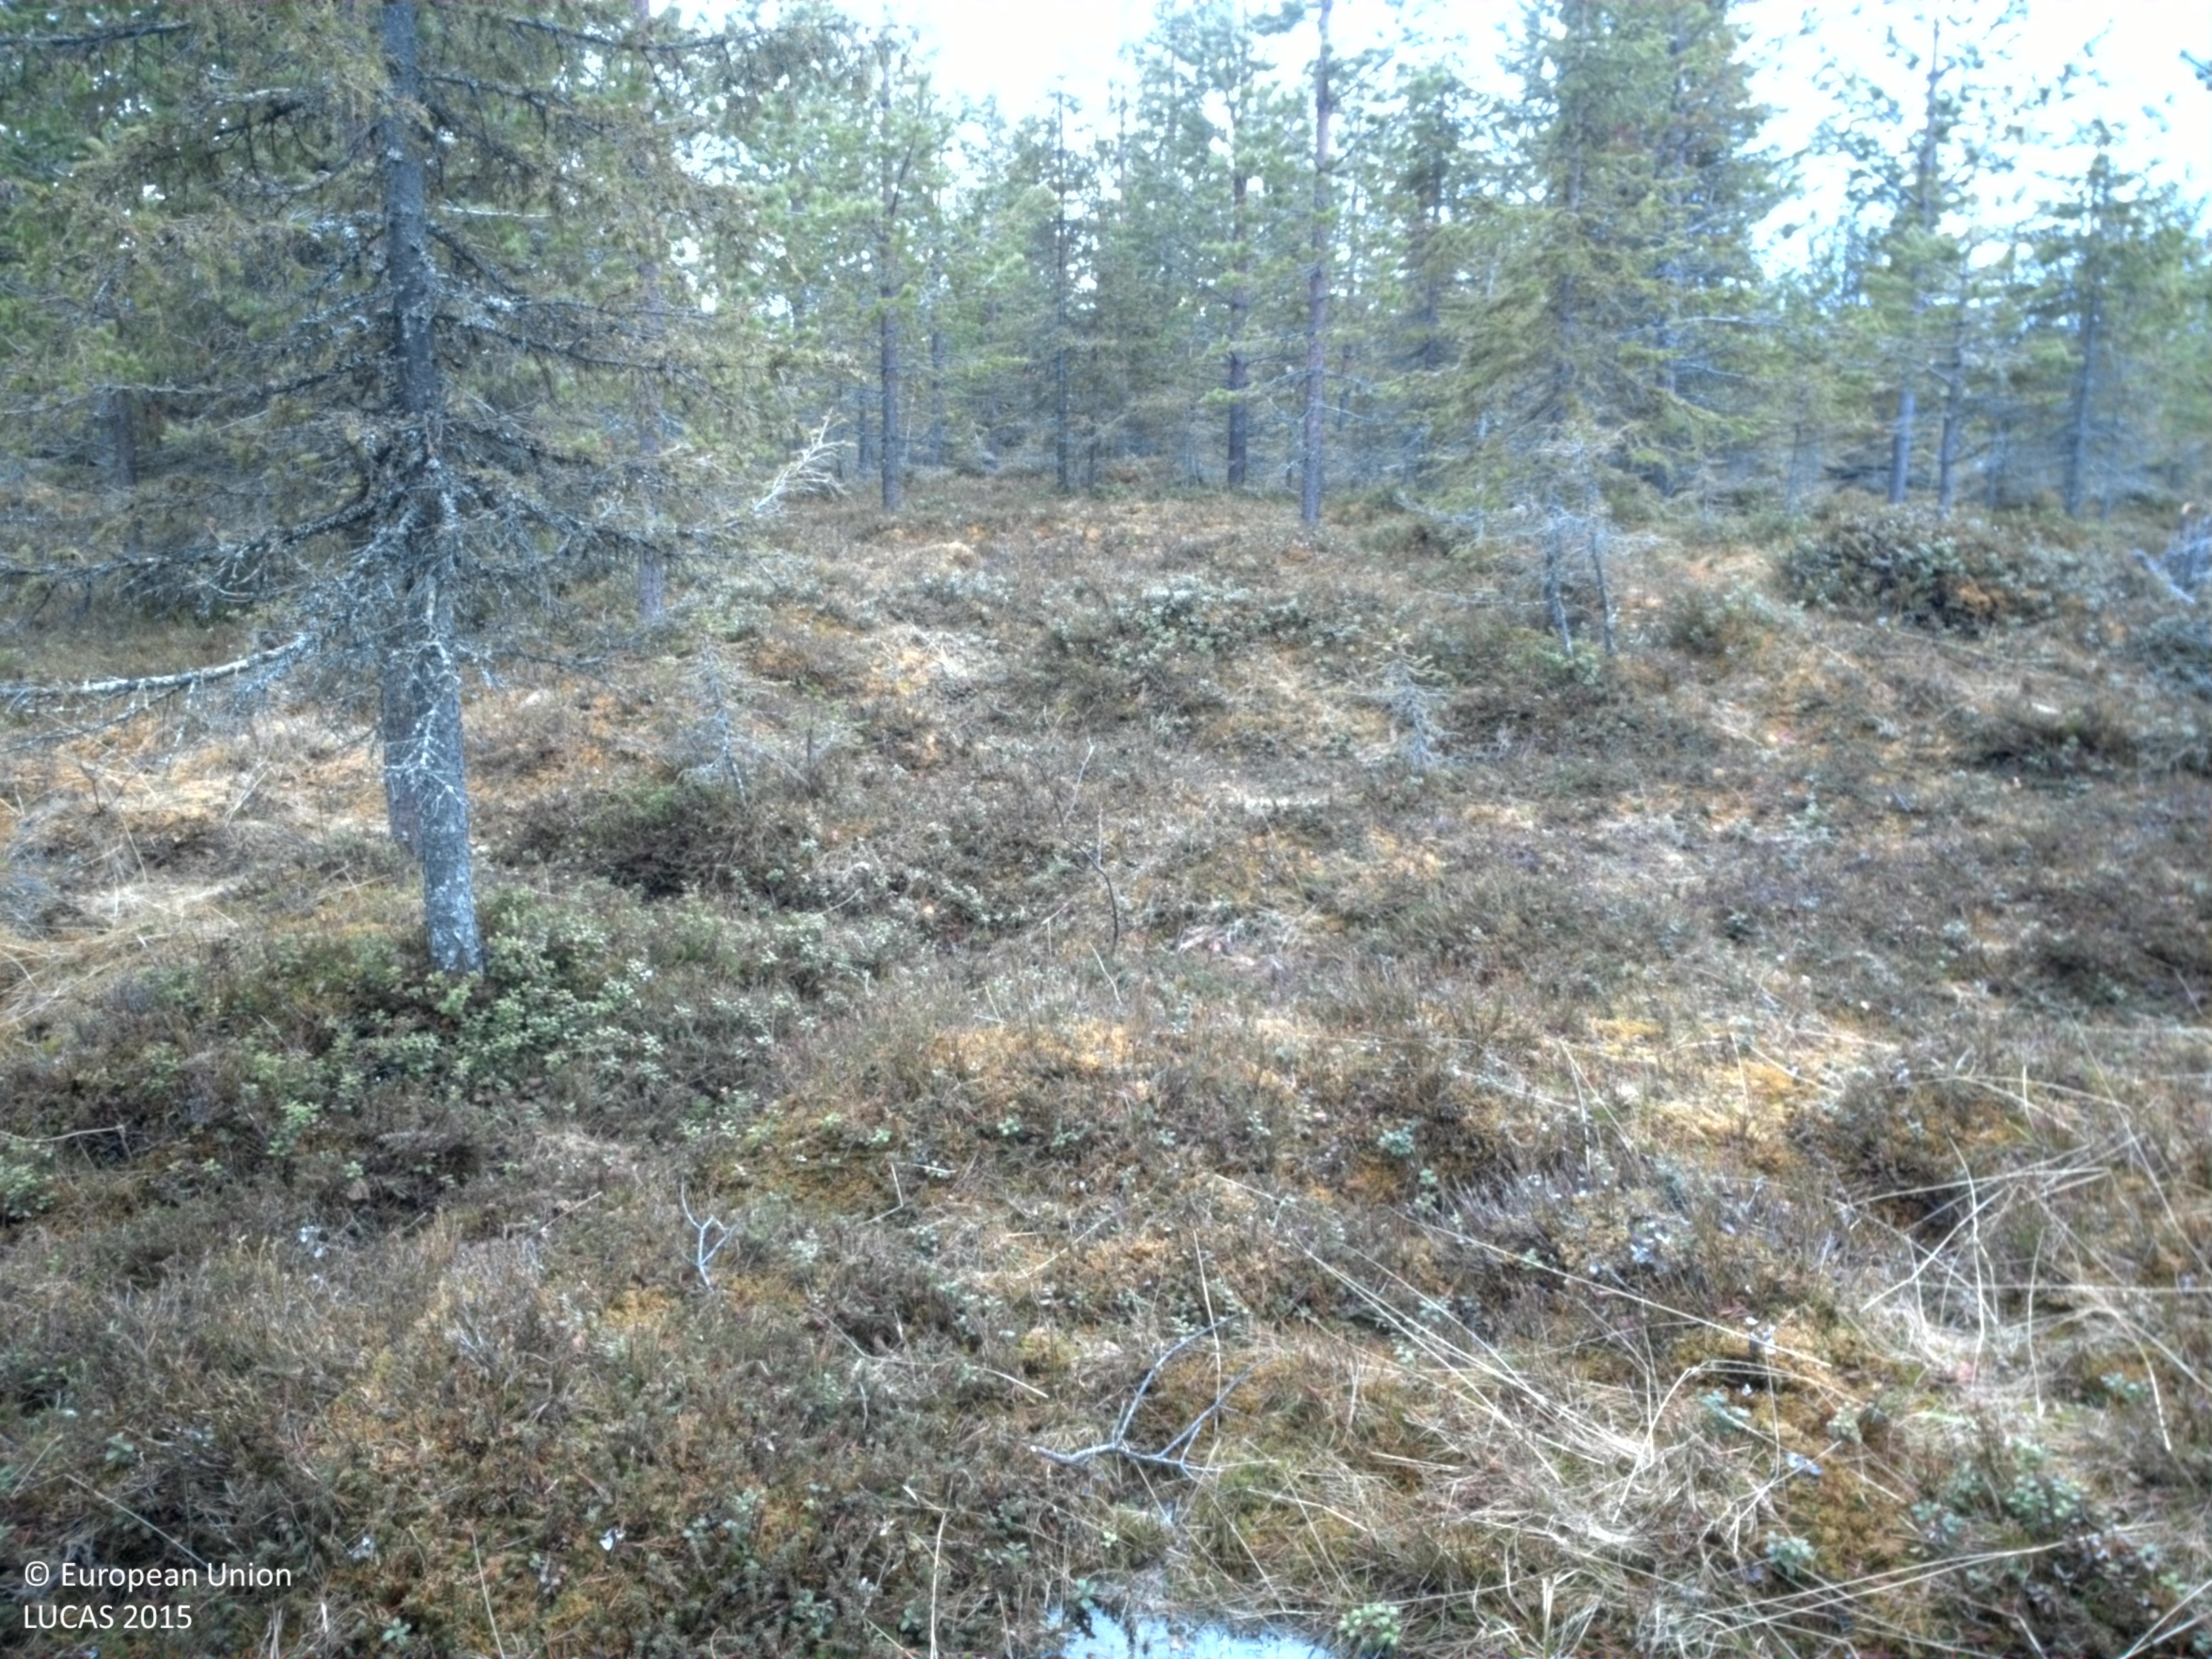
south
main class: Woodland
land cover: Other coniferous woodland
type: boreal forest
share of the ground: 50 - 75 %
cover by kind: coniferous forest trees 75 %, lichens and mosses 15 %, shrubs 10 %
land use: Forestry
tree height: > 5 m
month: June
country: SE
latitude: 66.9059
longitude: 20.9888
